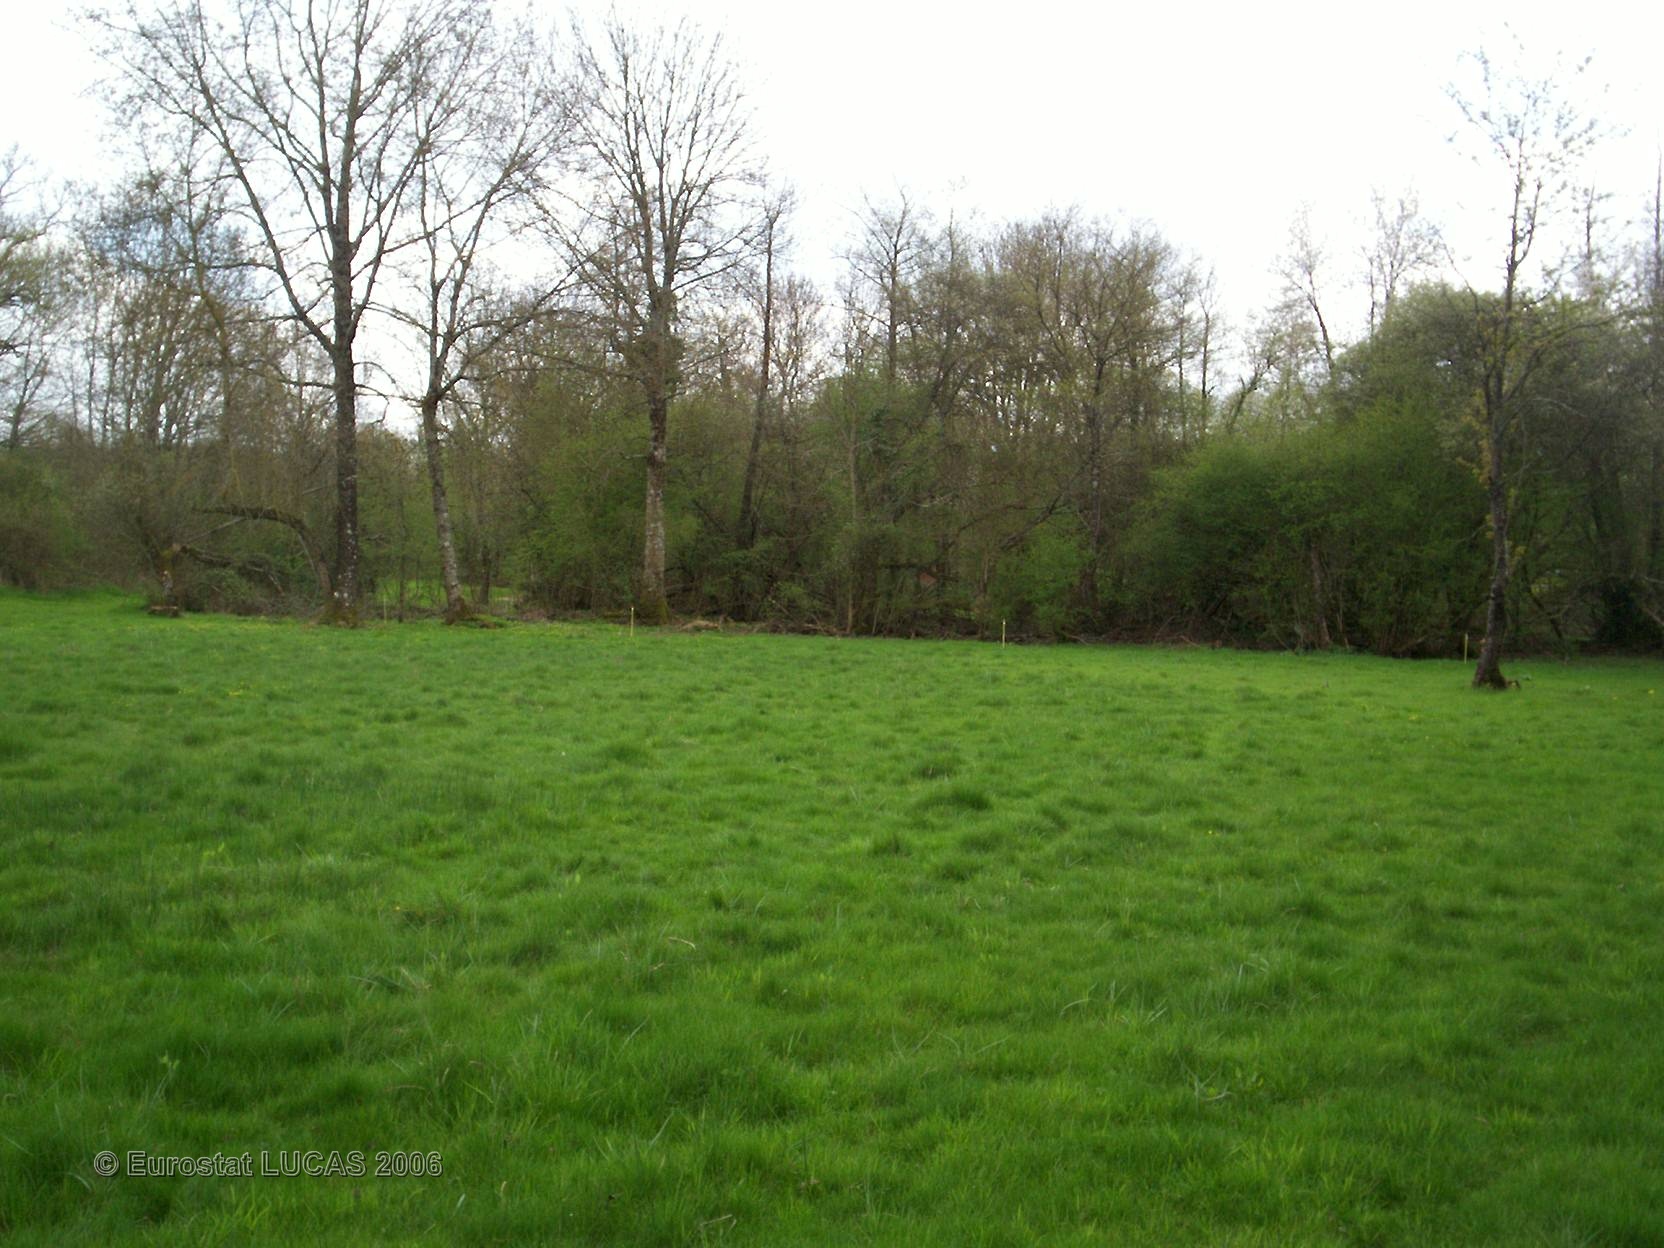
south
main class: Grassland
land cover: Grassland without tree/shrub cover
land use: Agriculture (excluding fallow land and kitchen gardens)
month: April
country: FR
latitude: 46.2384
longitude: 0.5301
